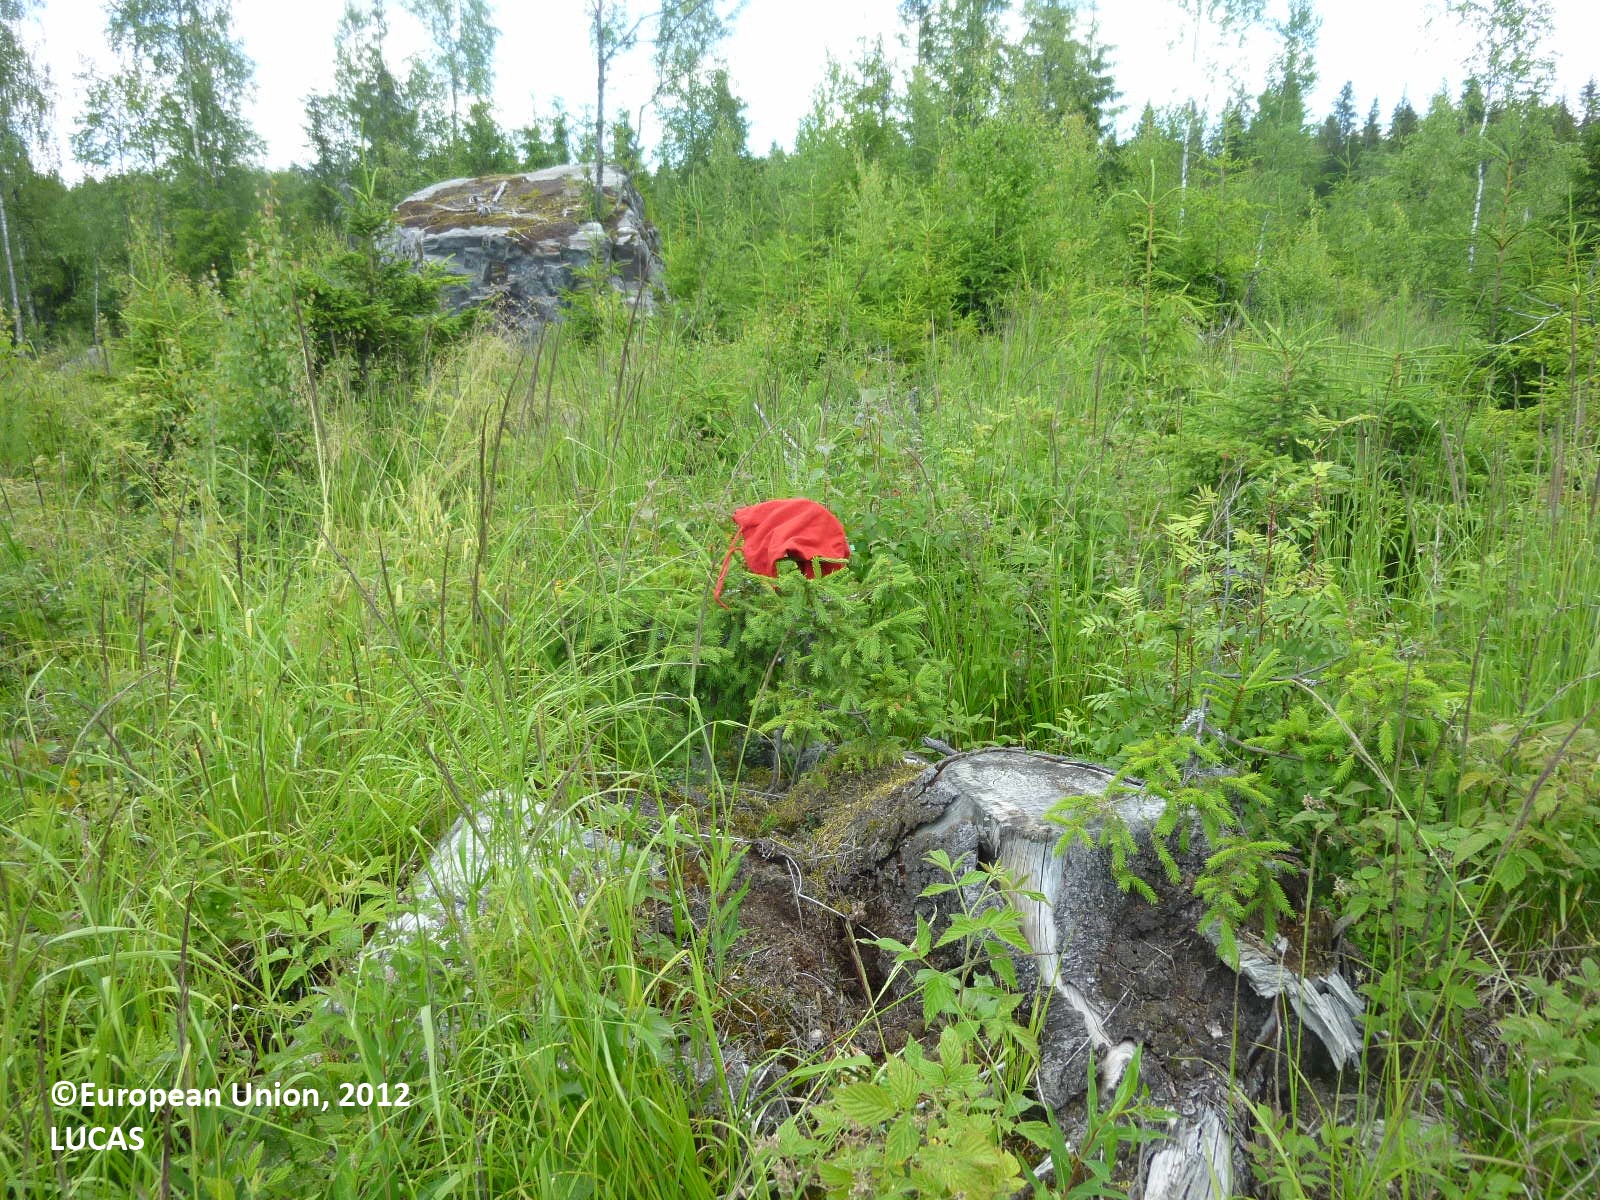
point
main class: Woodland
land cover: Spruce dominated mixed woodland
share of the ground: 50 - 75 %
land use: Forestry
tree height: < 5 m
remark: Clear cut
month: July
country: FI
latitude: 61.3794
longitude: 22.2437
